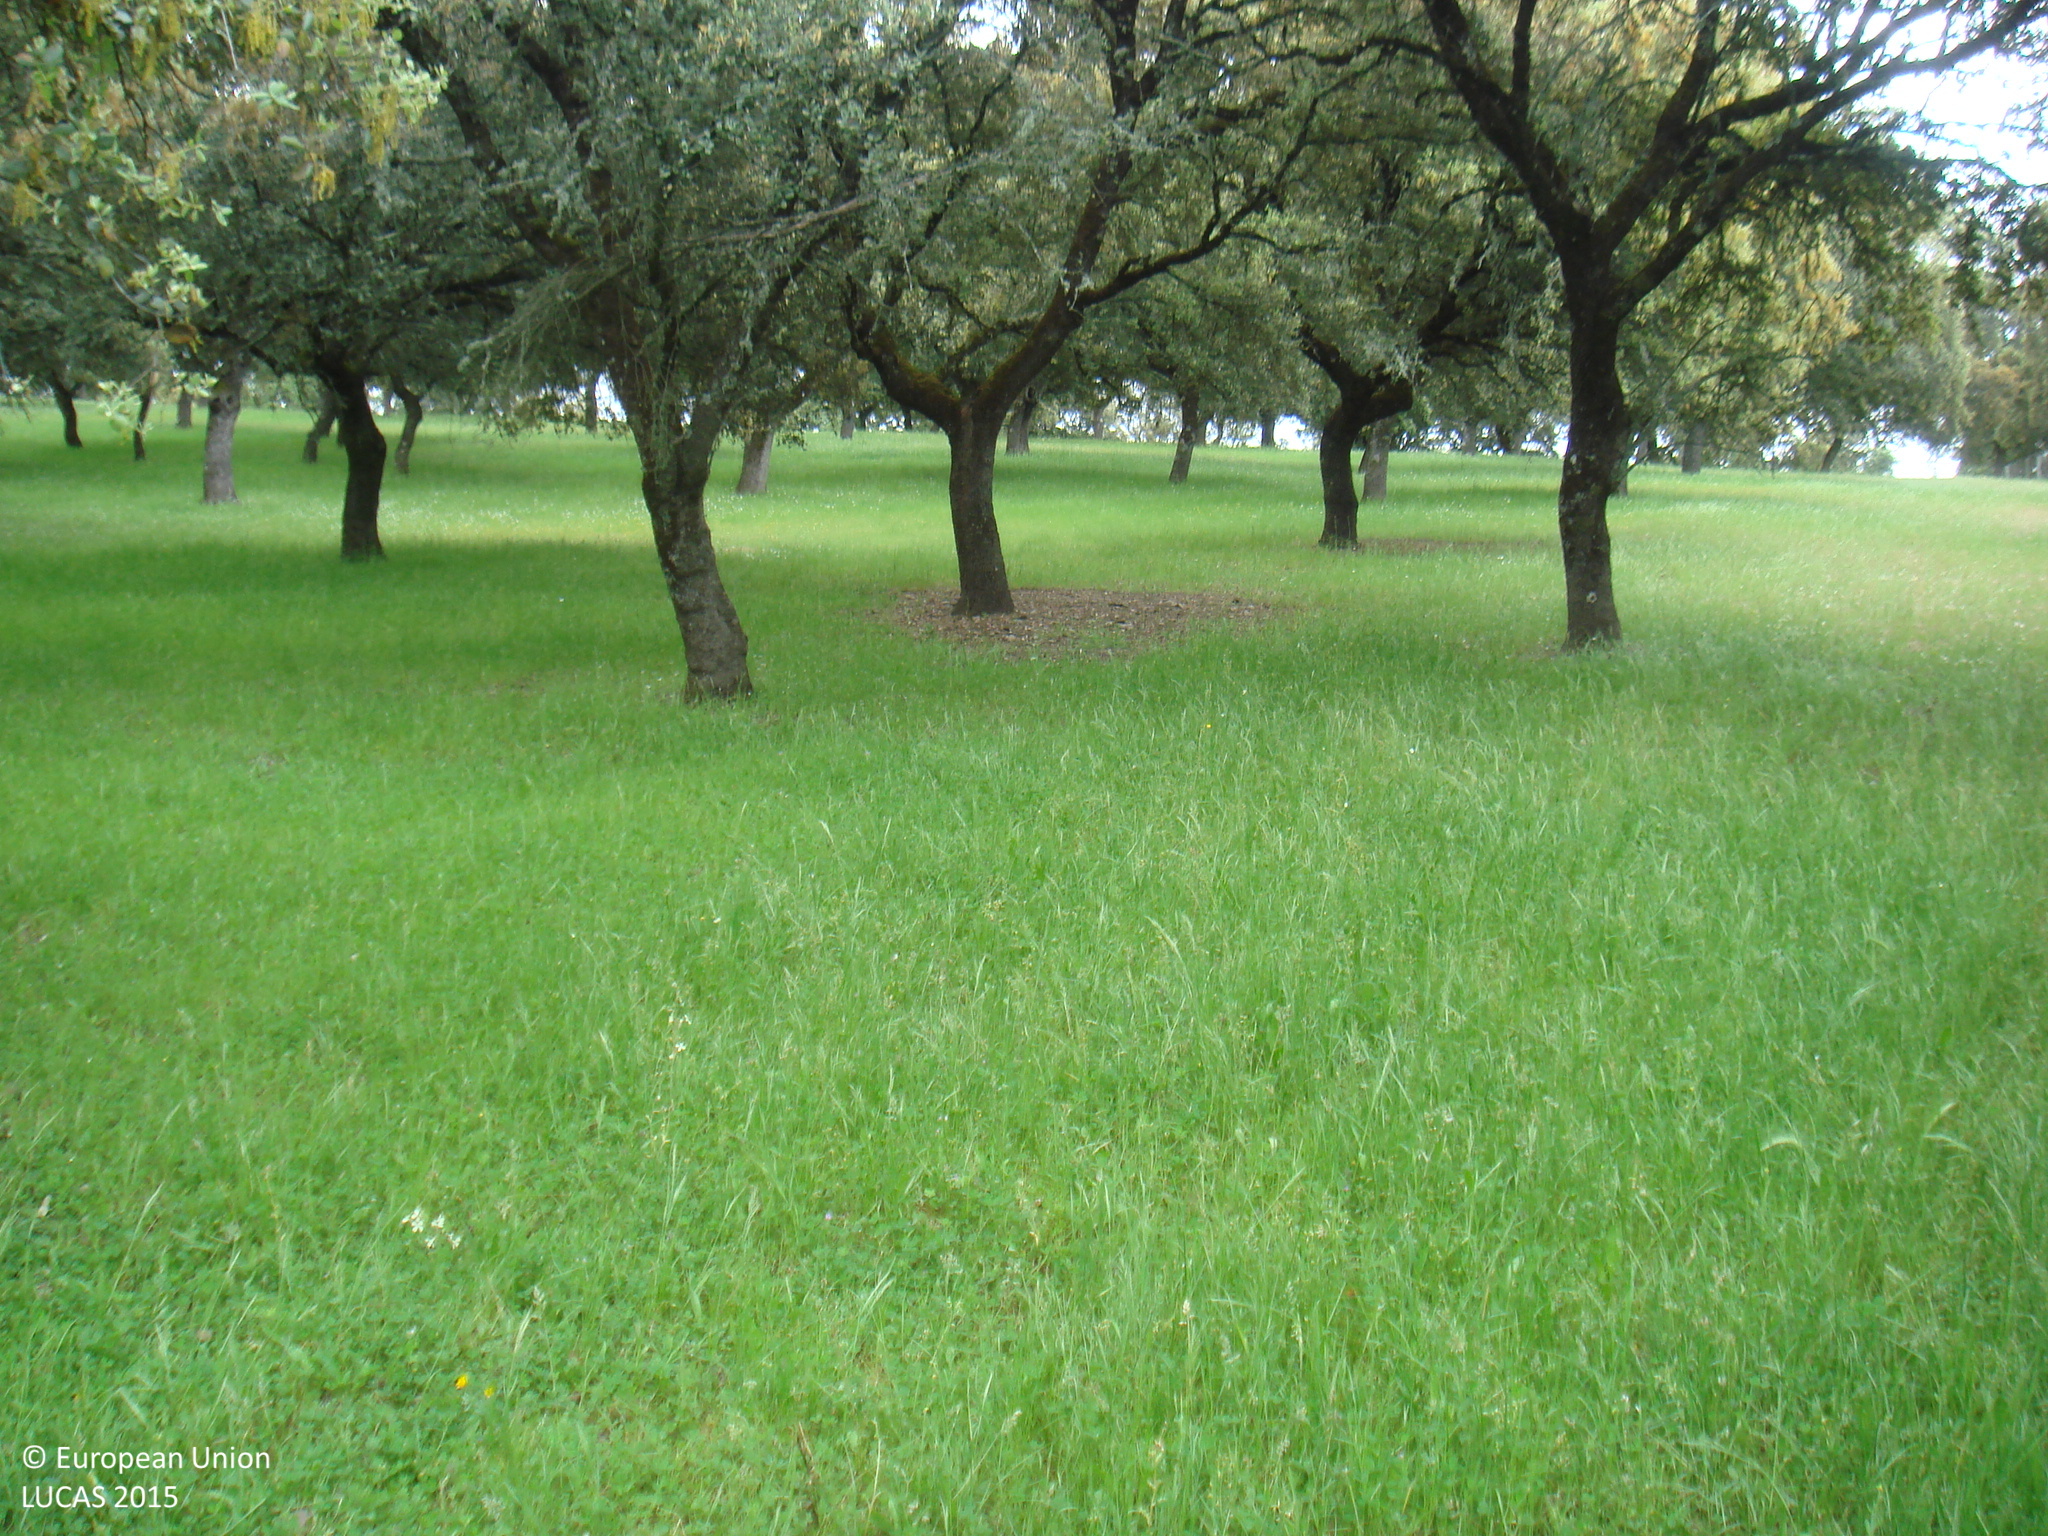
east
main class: Woodland
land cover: Broadleaved woodland
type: broadleaved evergreen forest
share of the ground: > 75 %
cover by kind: herbaceous plants 60 %, broadleaved forest trees 40 %
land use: Forestry
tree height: > 5 m
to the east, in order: Broadleaved woodland
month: April
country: ES
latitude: 38.2366
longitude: -4.3295
